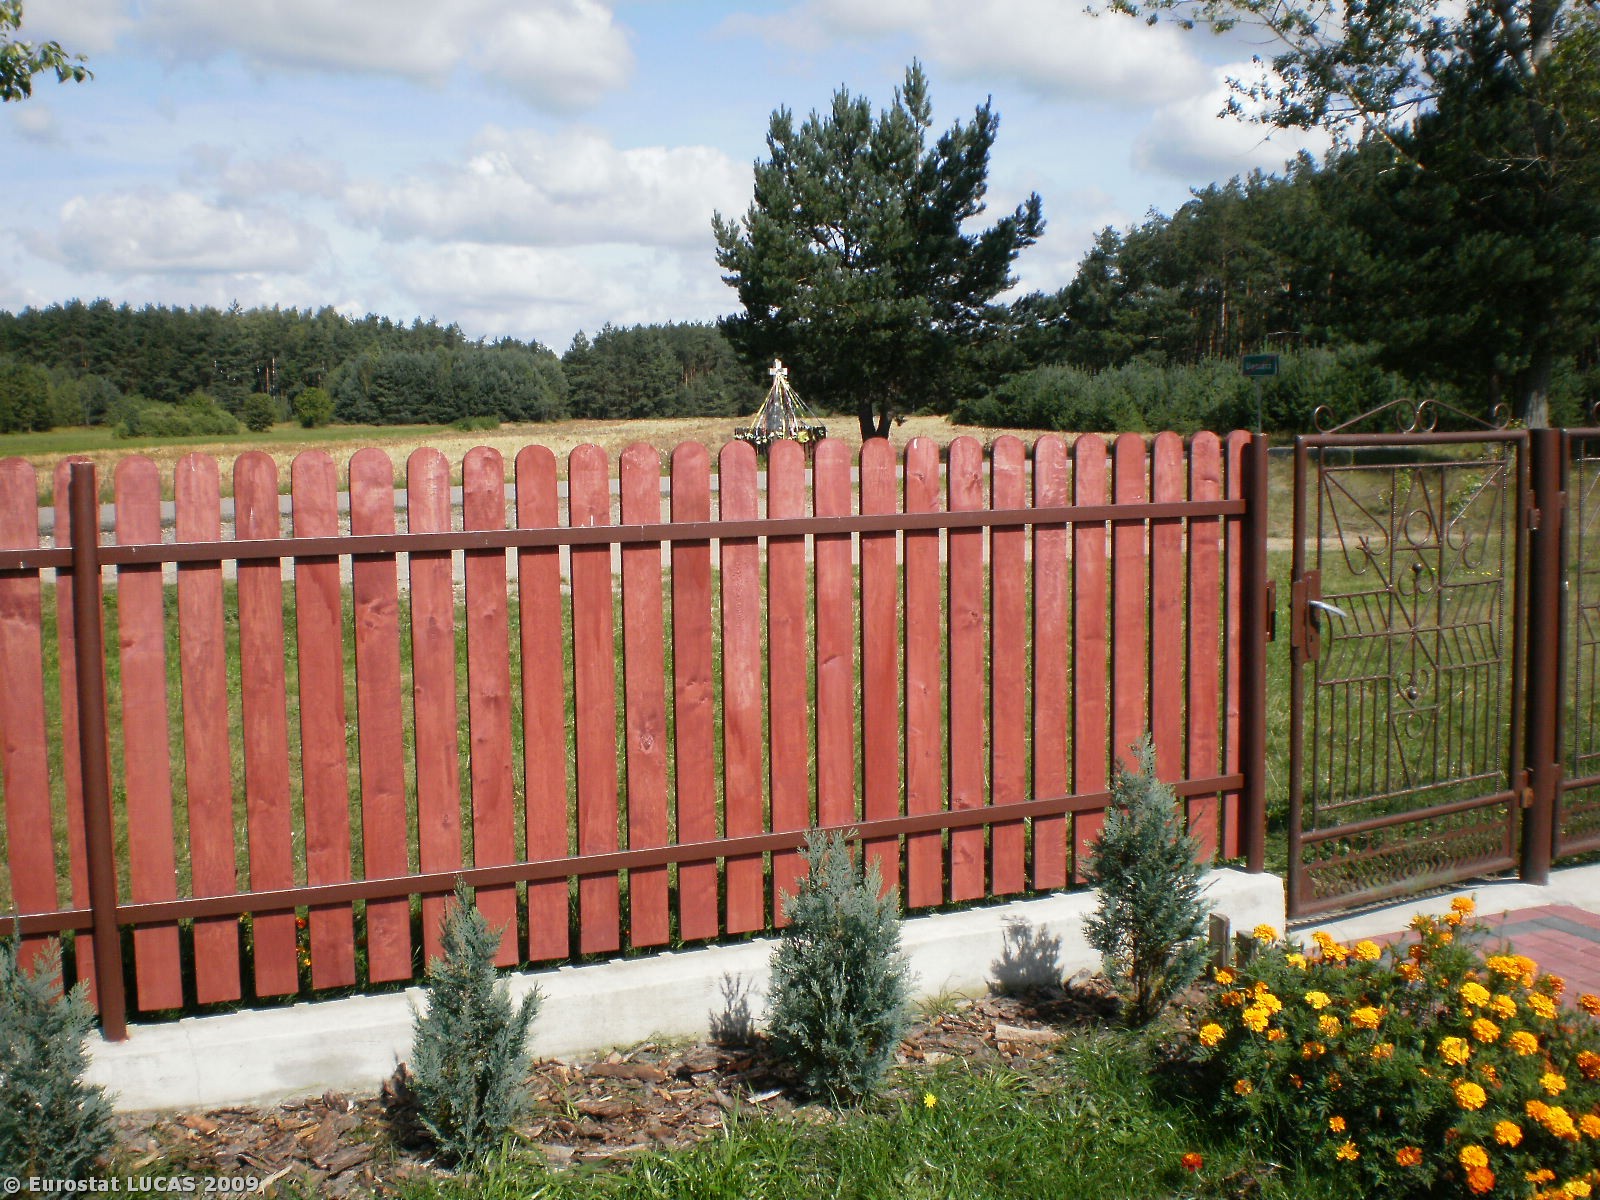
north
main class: Grassland
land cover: Grassland without tree/shrub cover
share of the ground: > 75 %
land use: Residential
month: August
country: PL
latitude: 52.5462
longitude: 22.0177
